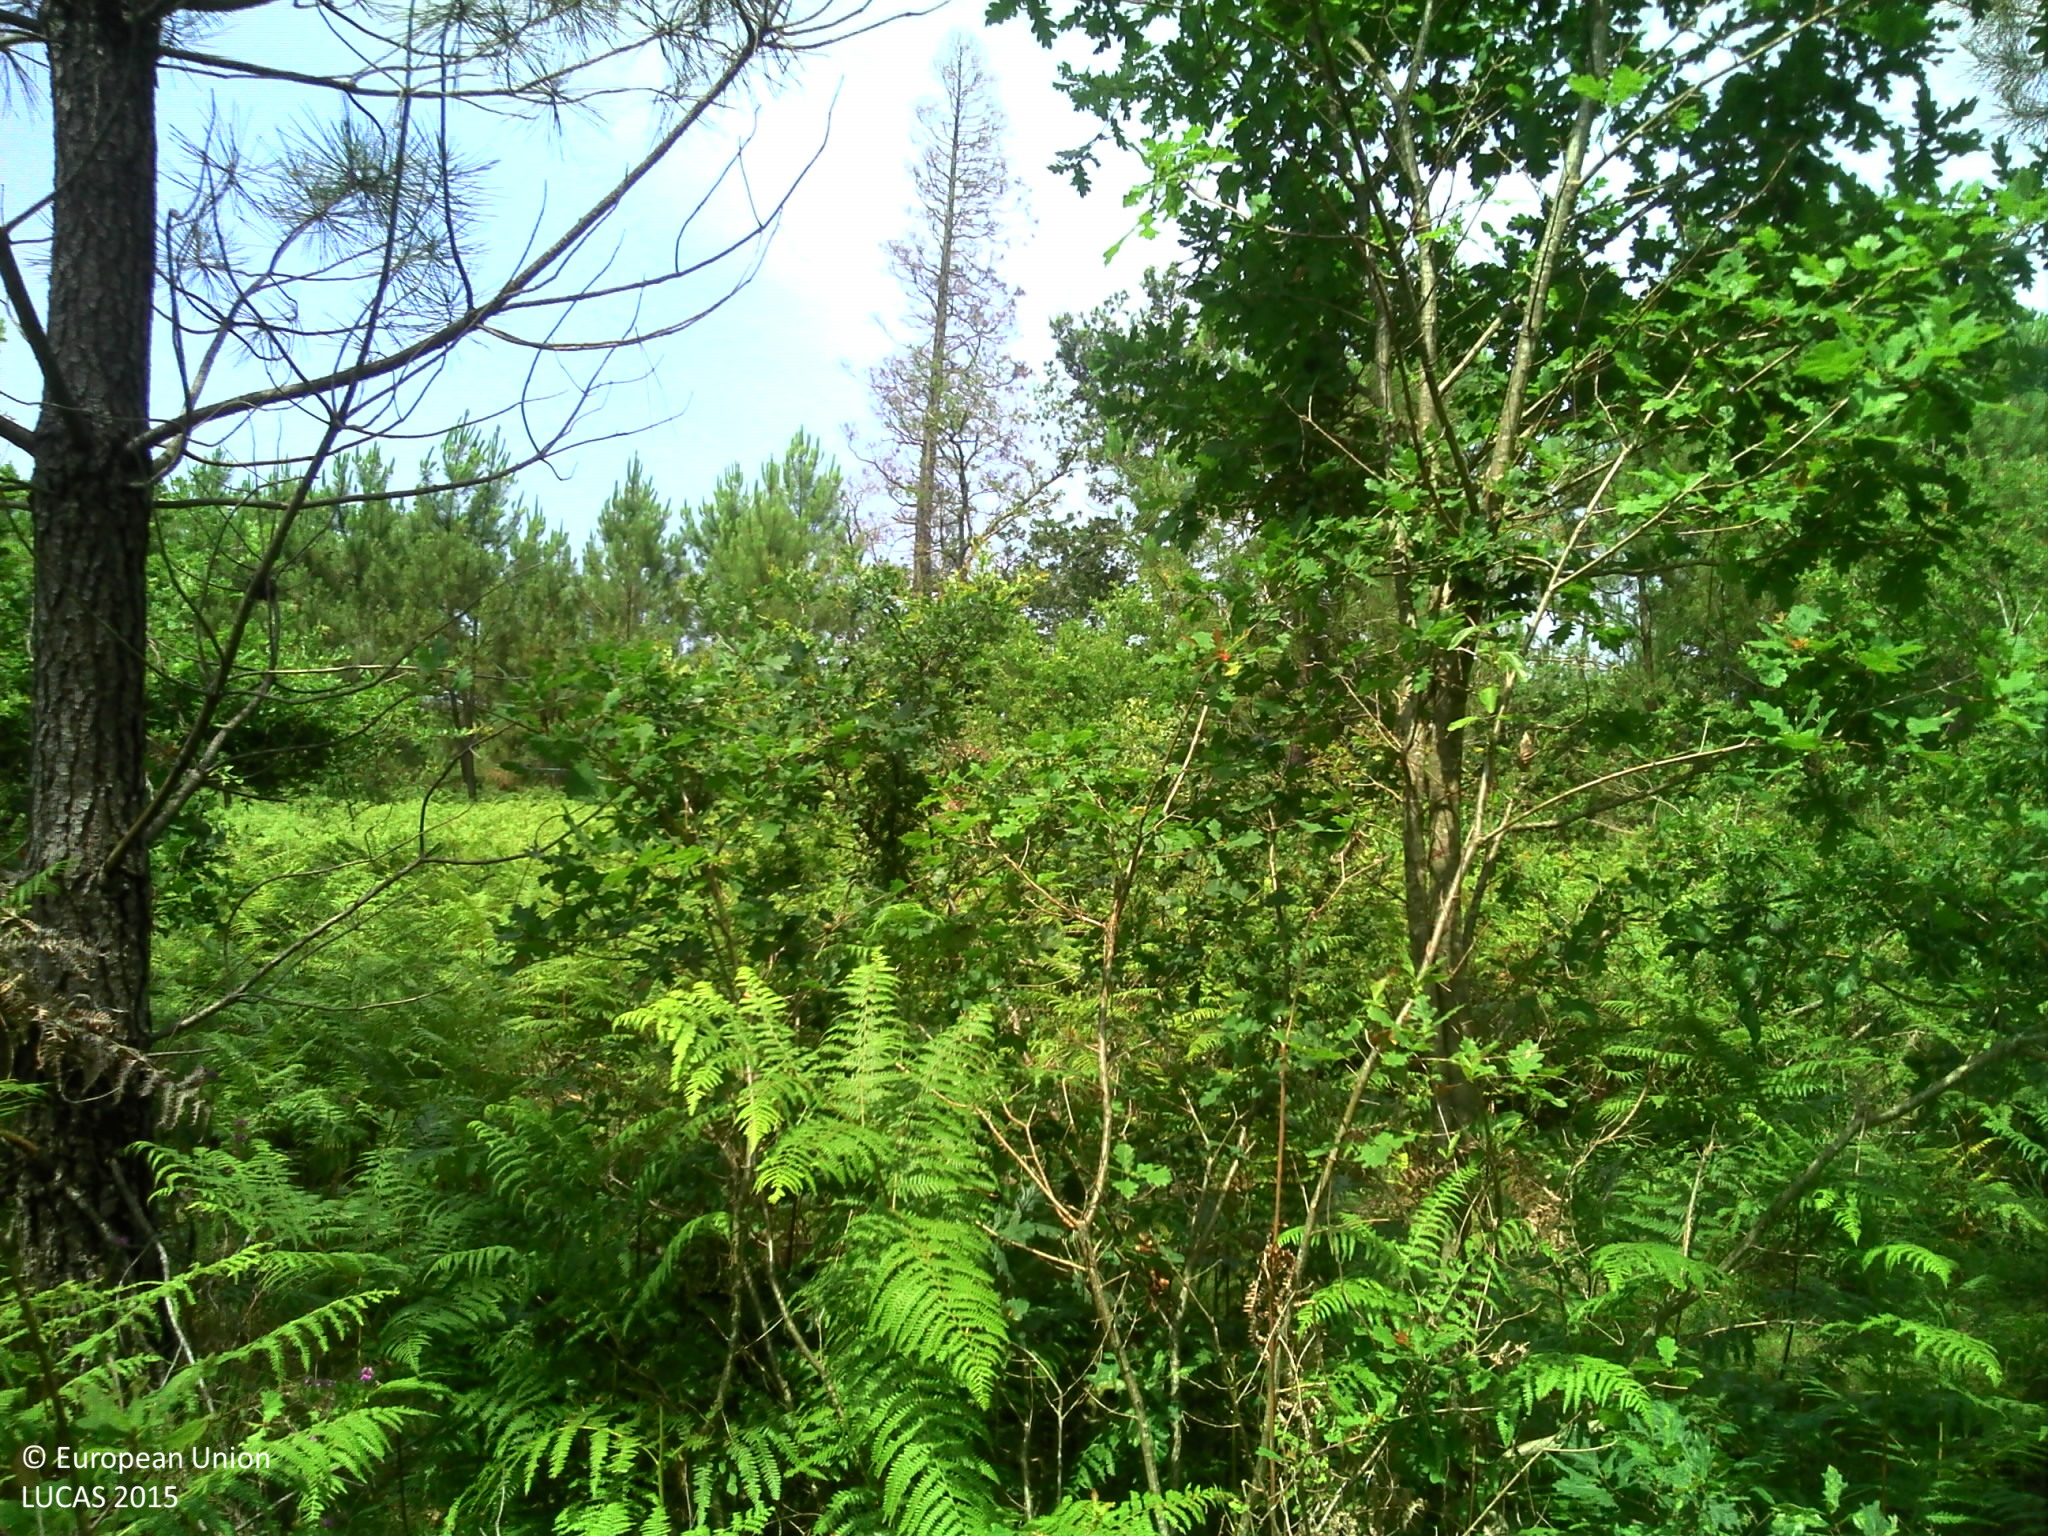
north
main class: Woodland
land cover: Pine dominated mixed woodland
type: coniferous forest of the mediterranean region
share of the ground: > 75 %
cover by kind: herbaceous plants 40 %, coniferous forest trees 30 %, broadleaved forest trees 25 %, shrubs 5 %
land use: Forestry
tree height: < 5 m
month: July
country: FR
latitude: 43.8539
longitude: -1.1770
